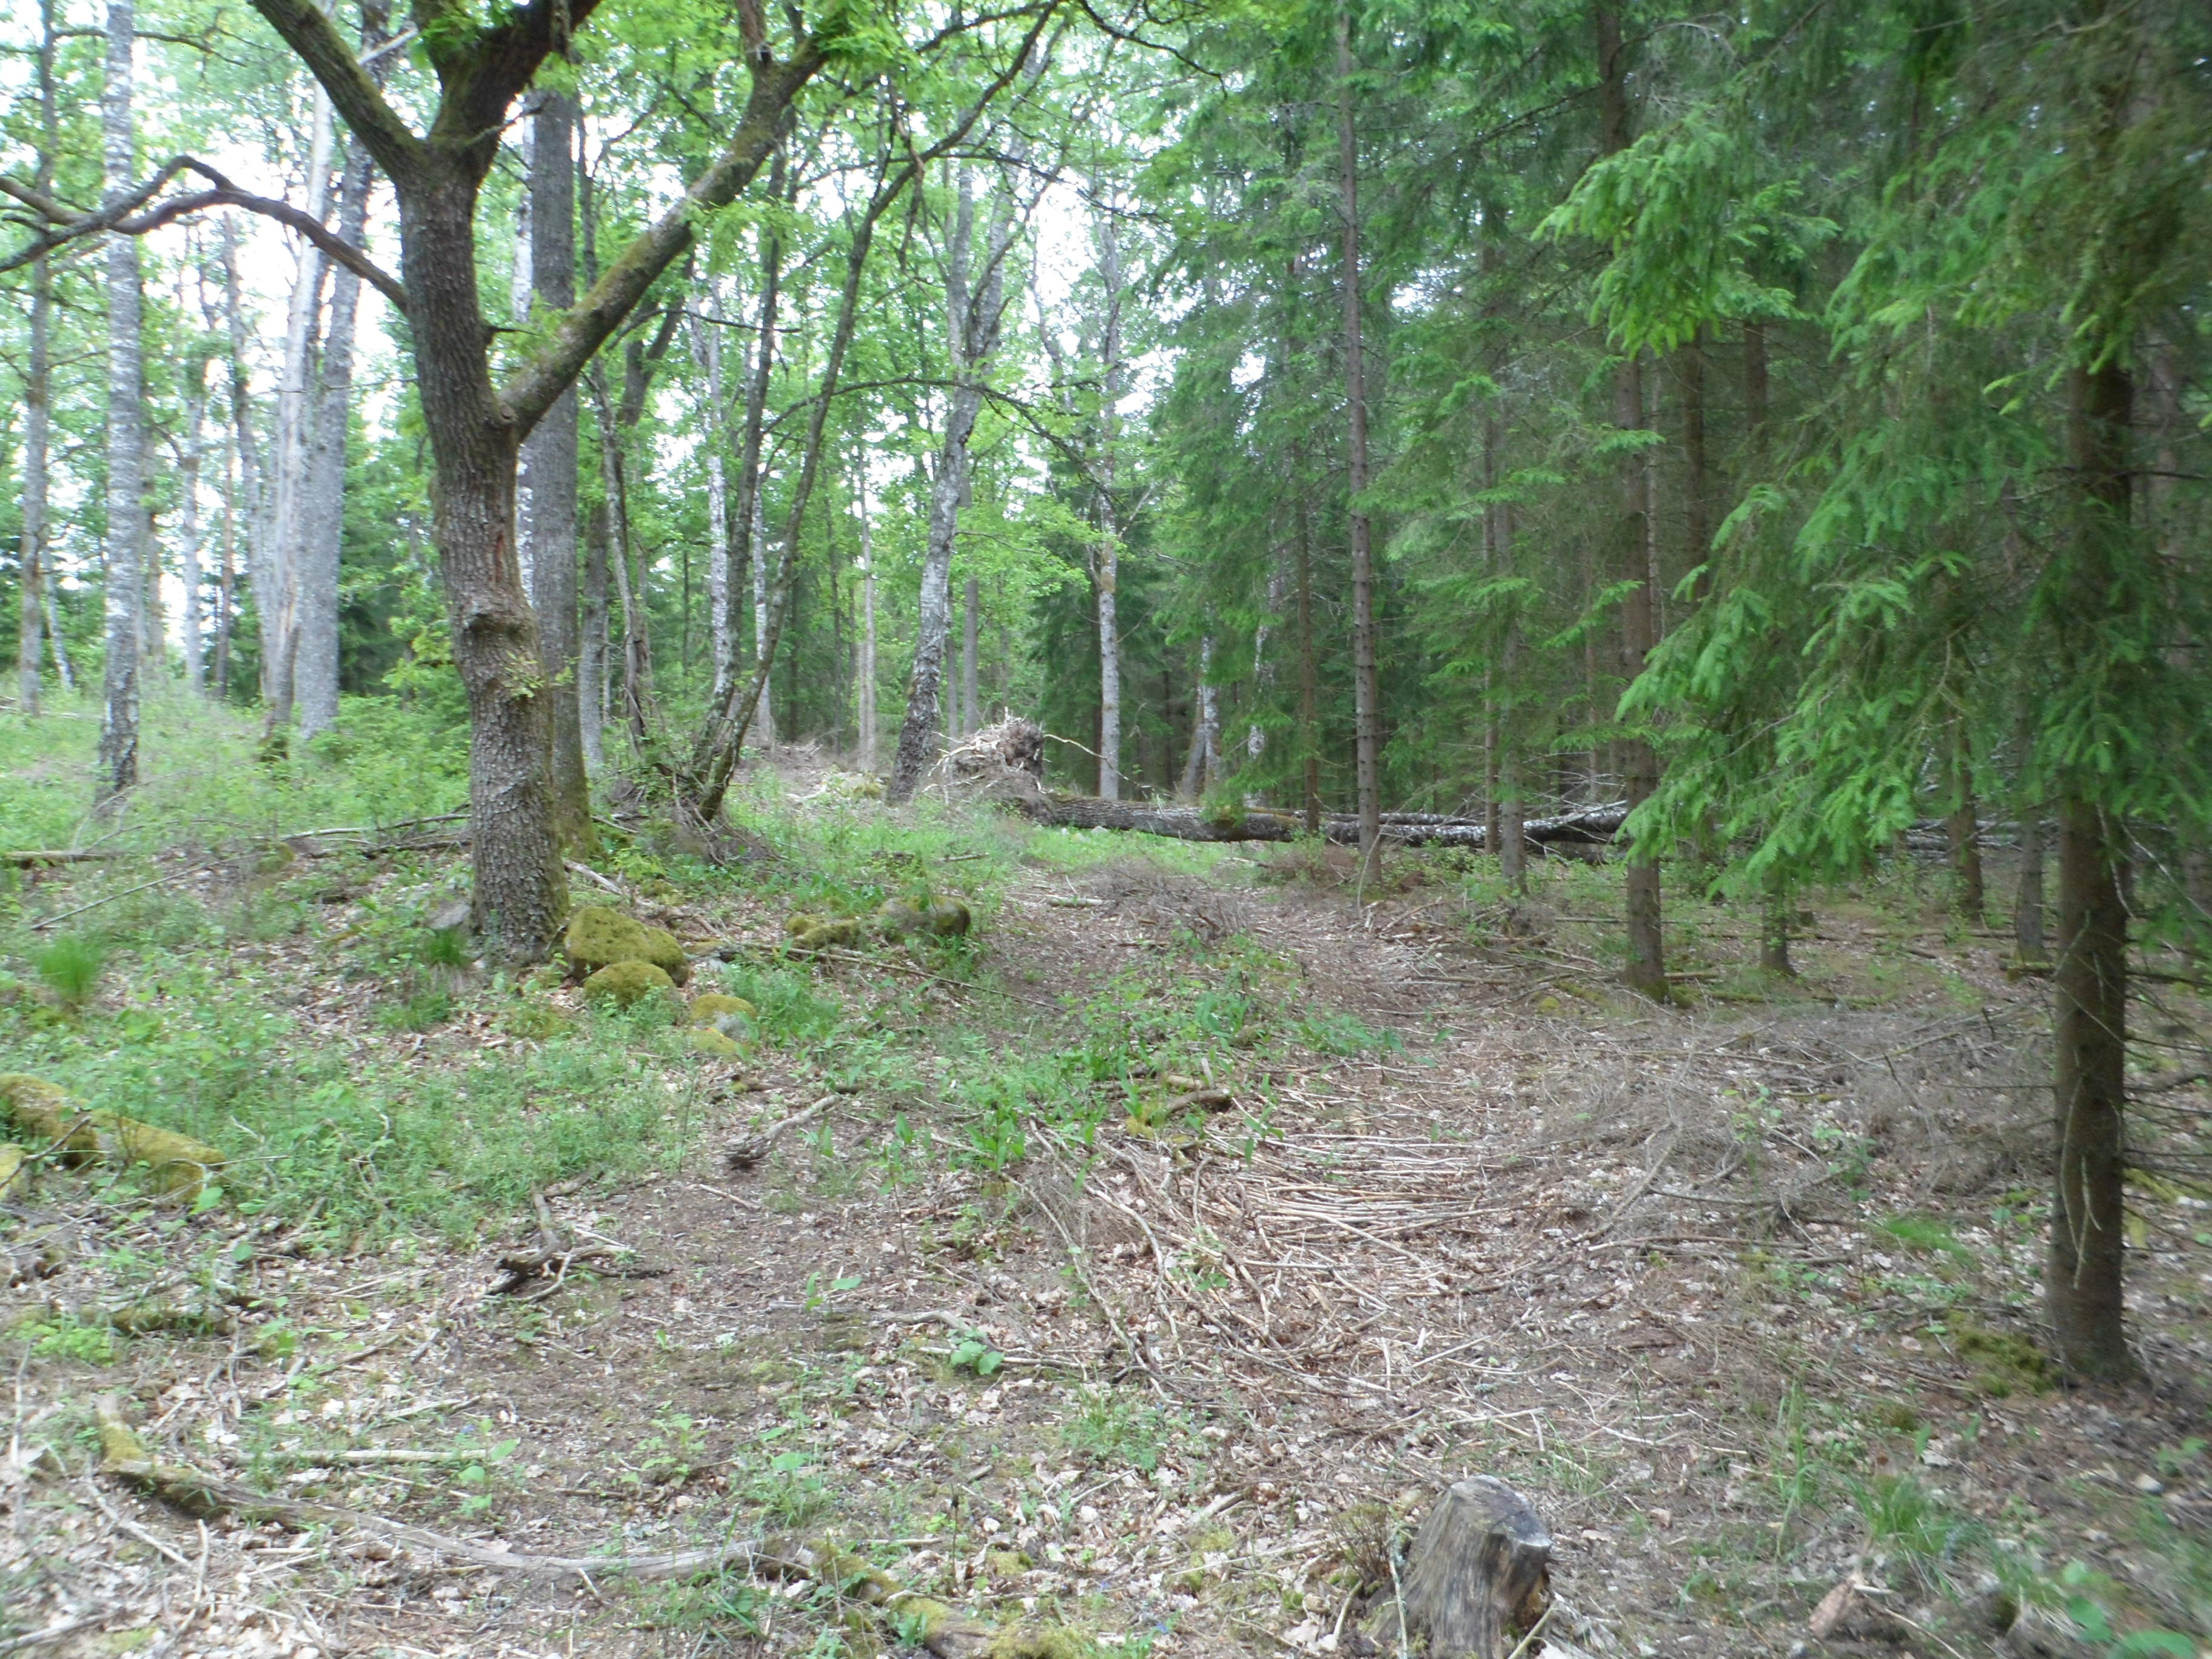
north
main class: Woodland
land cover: Spruce dominated mixed woodland
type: boreal forest
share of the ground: 50 - 75 %
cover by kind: coniferous forest trees 35 %, broadleaved forest trees 20 %, lichens and mosses 20 %, herbaceous plants 10 %, unconsolidated bare surface 10 %, shrubs 5 %
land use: Forestry
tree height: > 5 m
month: June
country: SE
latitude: 56.8078
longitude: 14.5993
